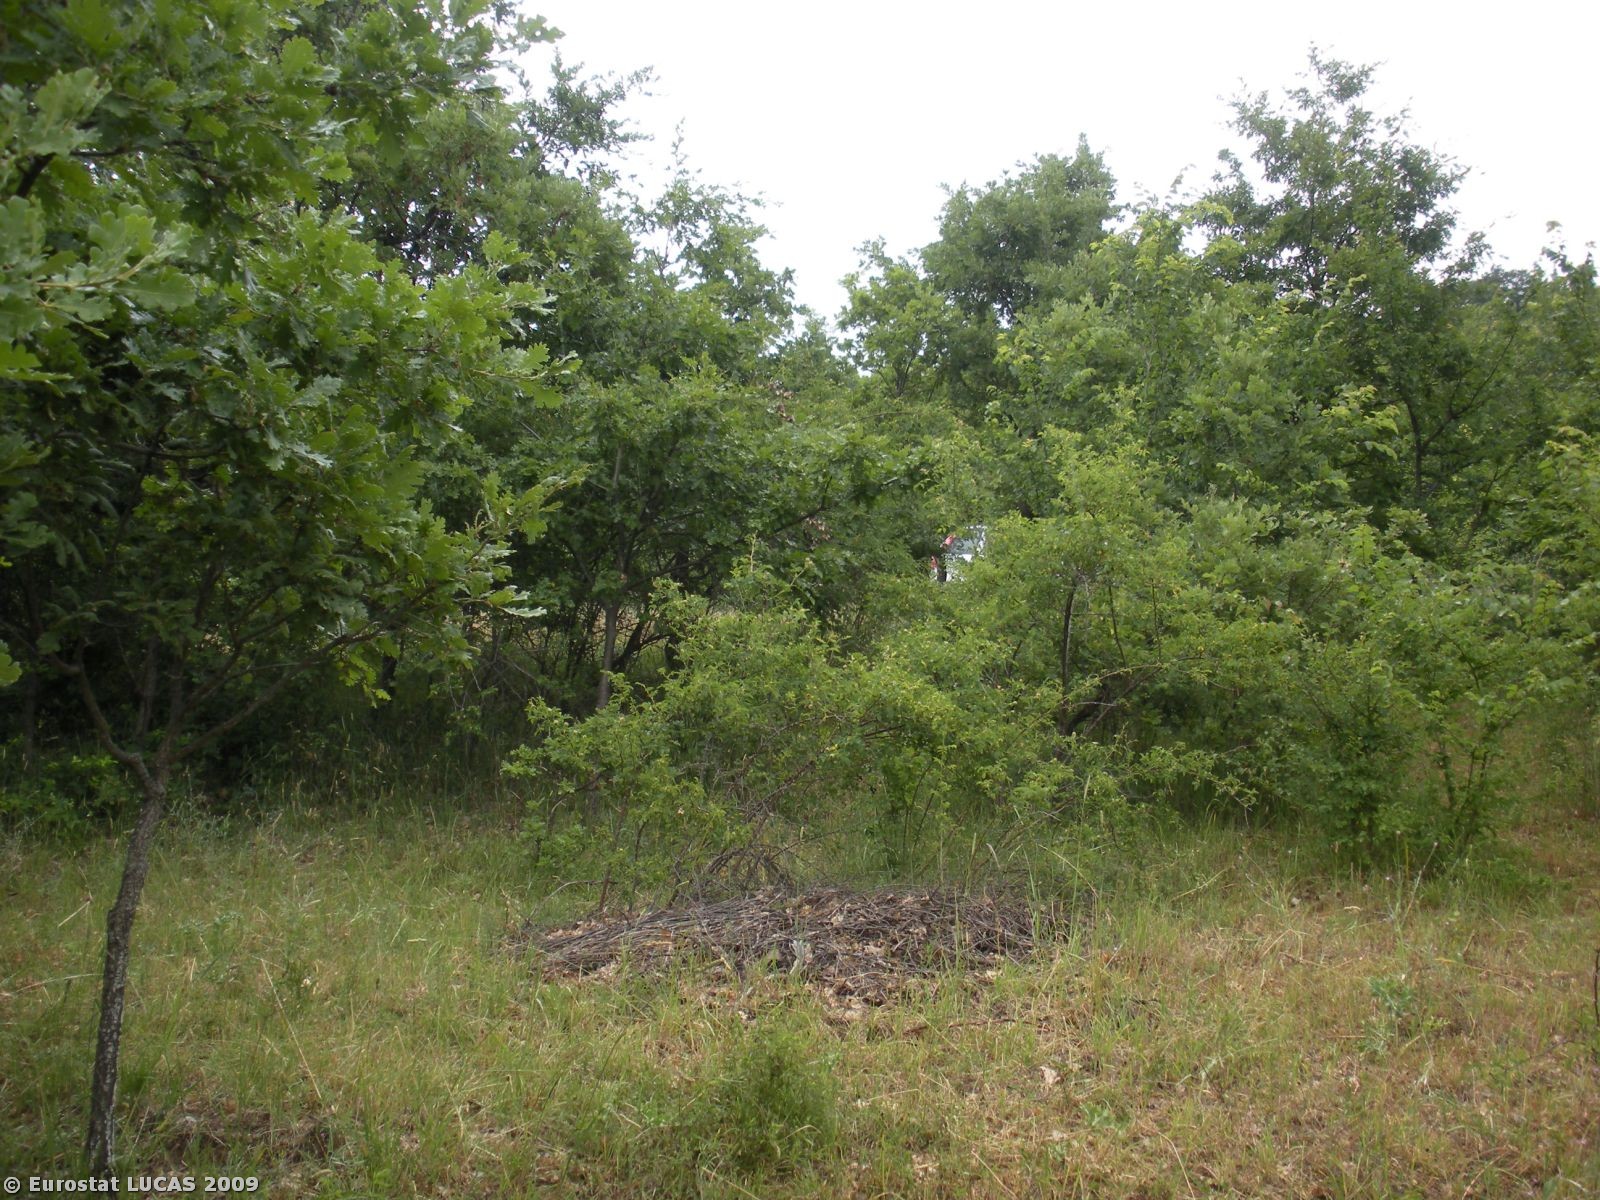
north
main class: Woodland
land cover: Broadleaved woodland
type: mesophytic deciduous forest
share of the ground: > 75 %
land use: Forestry
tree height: > 5 m
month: June
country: IT
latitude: 40.5131
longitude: 15.7955
